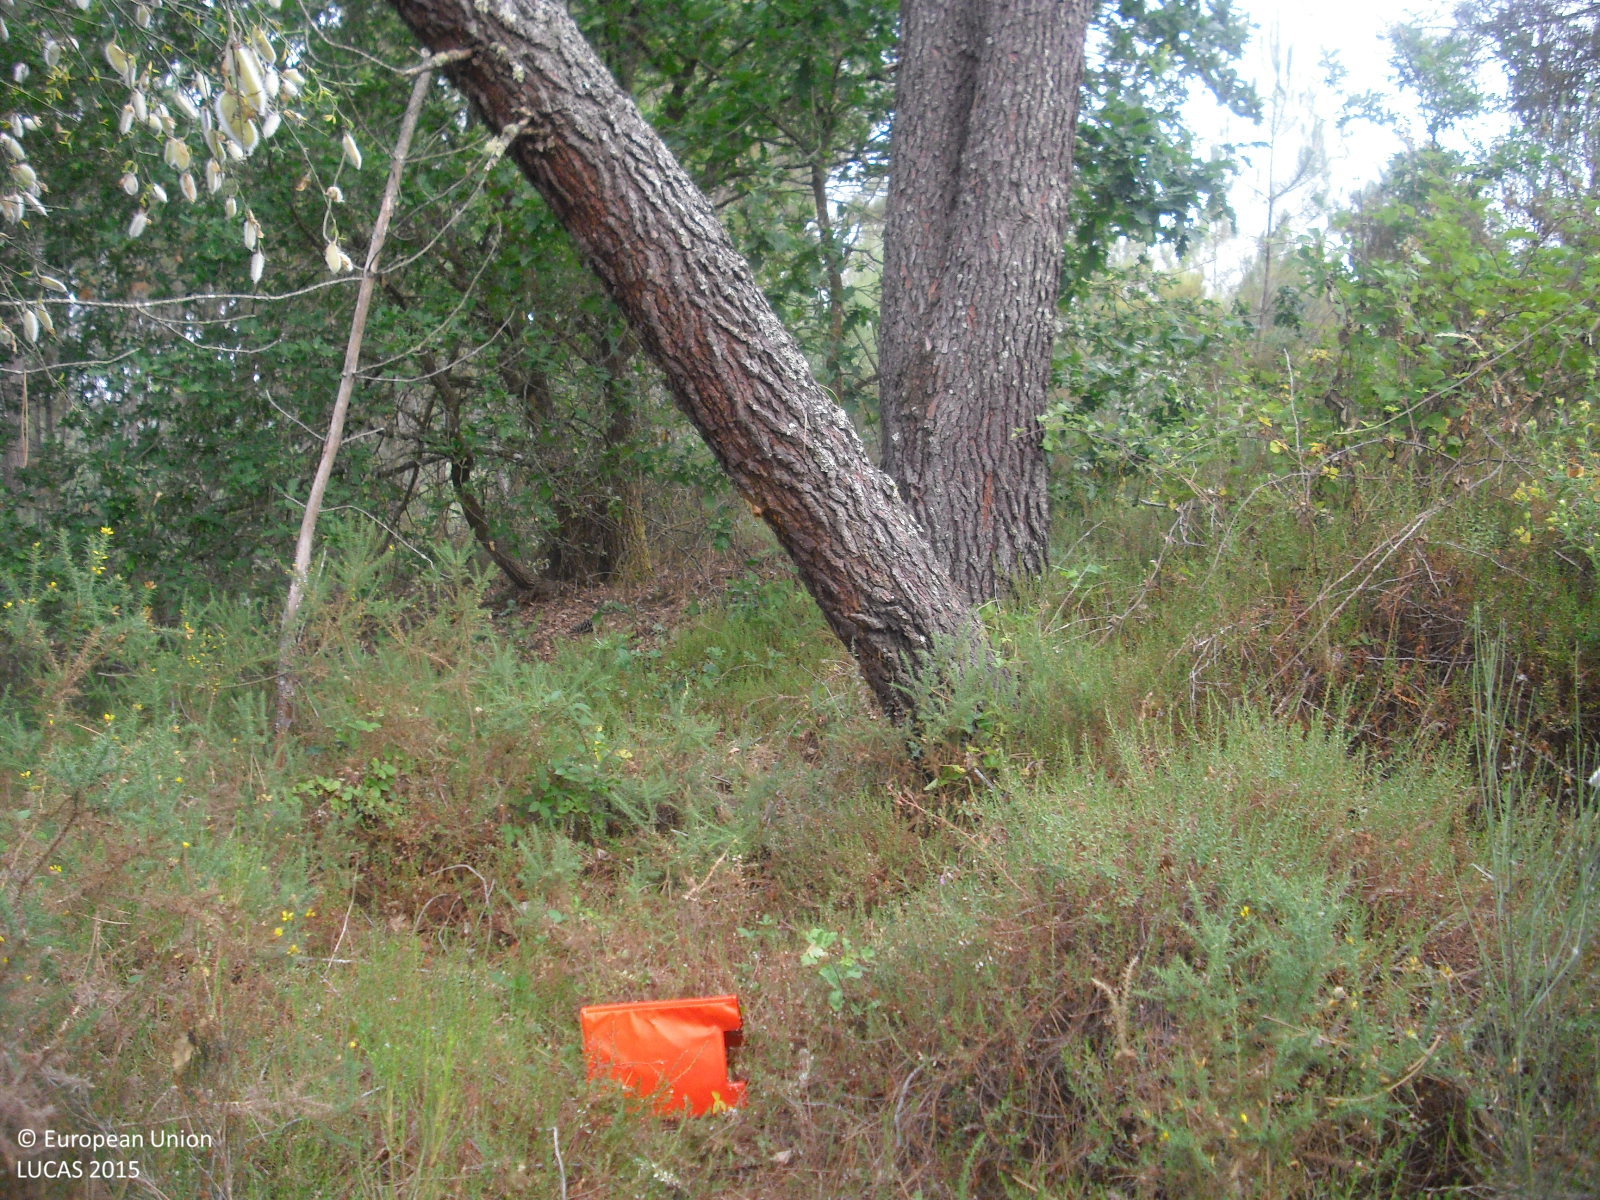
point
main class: Woodland
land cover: Pine dominated mixed woodland
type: hemiboreal forest and nemoral coniferous forest and mixed broadleaved-coniferous forest
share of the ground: > 75 %
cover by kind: shrubs 60 %, coniferous forest trees 30 %, broadleaved forest trees 10 %
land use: Forestry
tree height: > 5 m
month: July
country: ES
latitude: 42.5455
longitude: -7.4453
